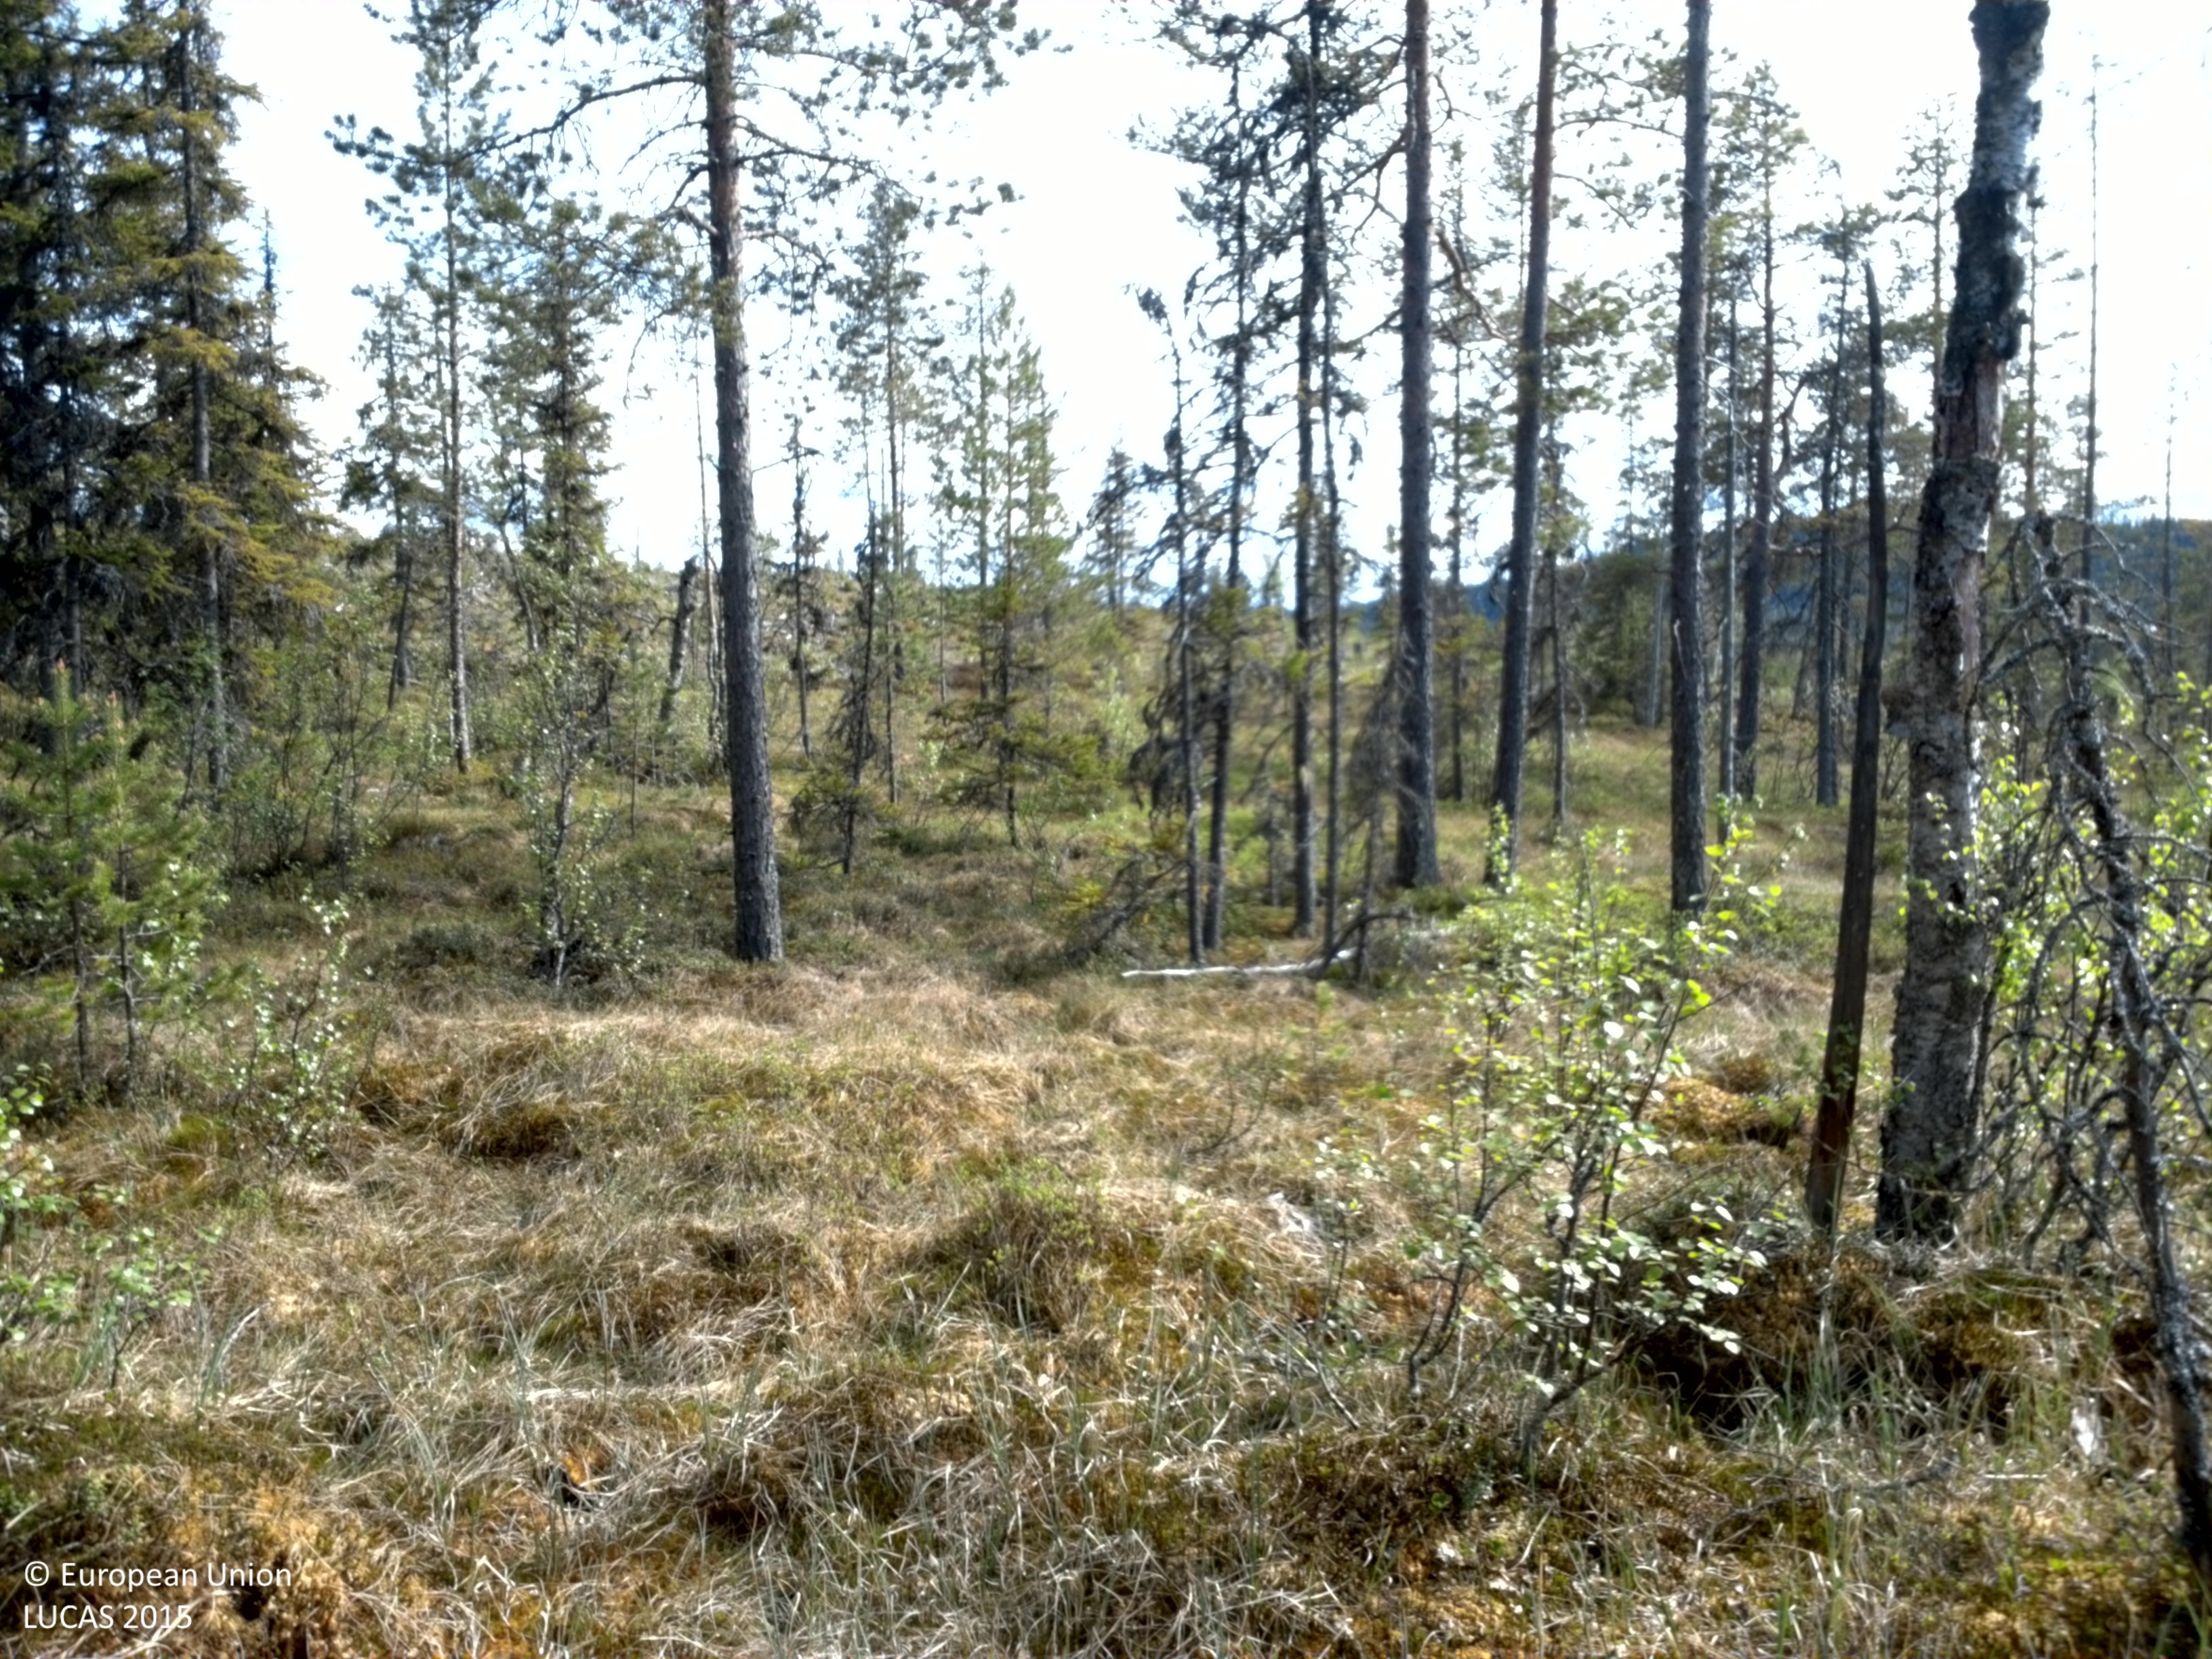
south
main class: Woodland
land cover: Pine dominated mixed woodland
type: boreal forest
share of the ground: 10 - 25 %
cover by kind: herbaceous plants 35 %, lichens and mosses 35 %, coniferous forest trees 15 %, broadleaved forest trees 10 %, shrubs 5 %
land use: Forestry
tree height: > 5 m
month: June
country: SE
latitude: 61.9352
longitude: 13.7010
